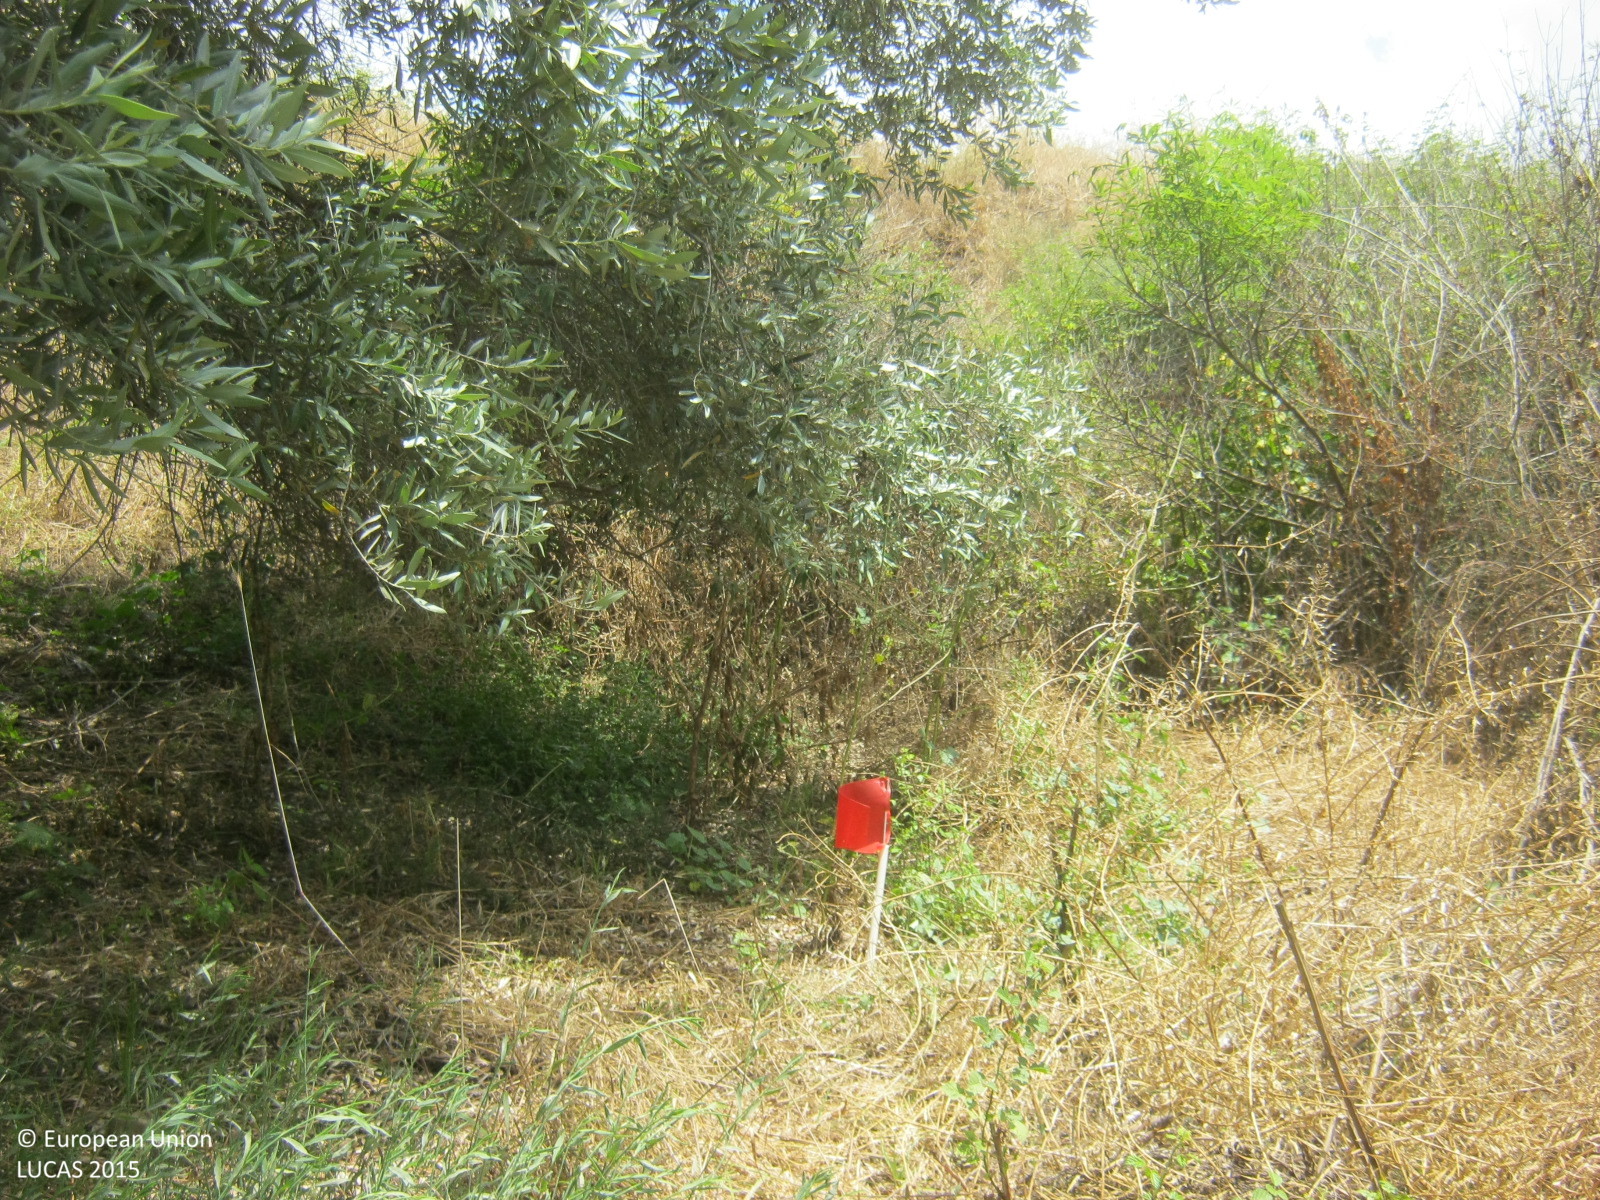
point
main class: Cropland
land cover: Olive groves
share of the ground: 50 - 75 %
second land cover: Grassland without tree/shrub cover
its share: > 75 %
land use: Abandoned areas
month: June
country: CY
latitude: 35.0452
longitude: 32.8972
